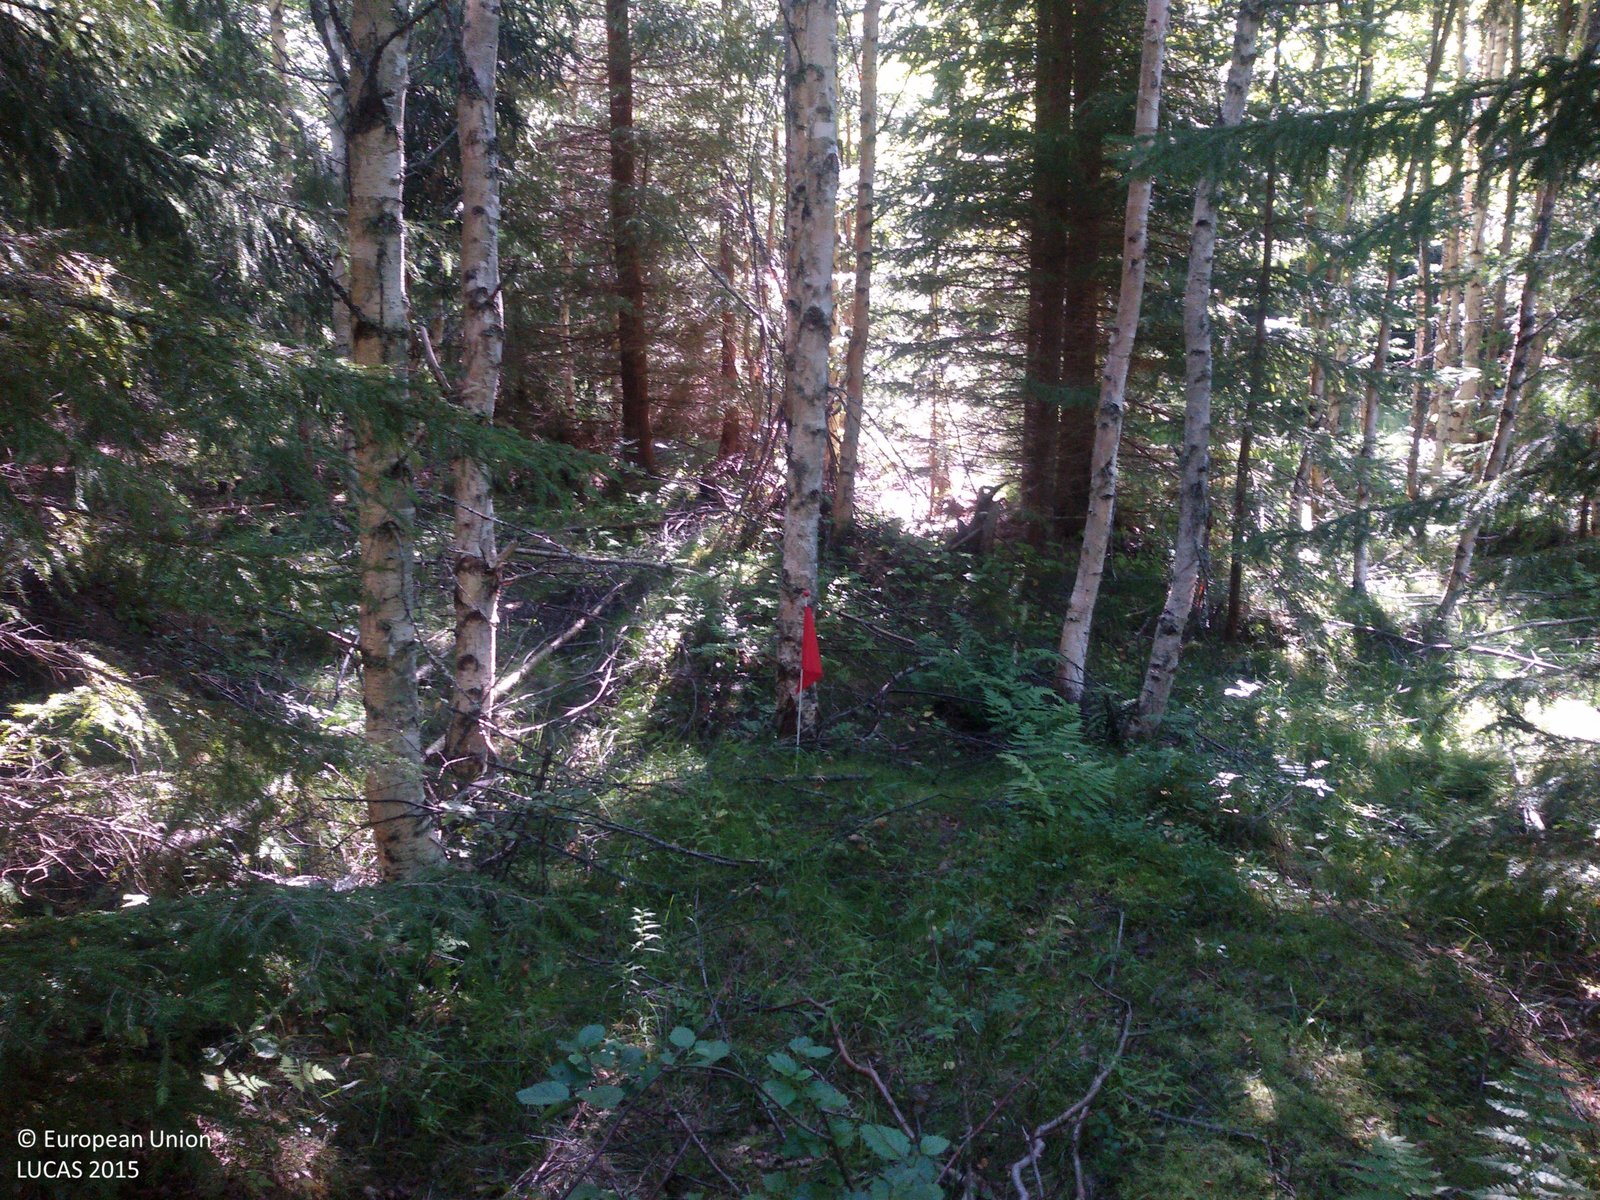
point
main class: Woodland
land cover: Spruce dominated mixed woodland
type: boreal forest
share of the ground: > 75 %
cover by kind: coniferous forest trees 50 %, broadleaved forest trees 30 %, shrubs 10 %, lichens and mosses 10 %
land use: Forestry
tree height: > 5 m
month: August
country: SE
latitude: 60.7016
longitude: 16.4543
